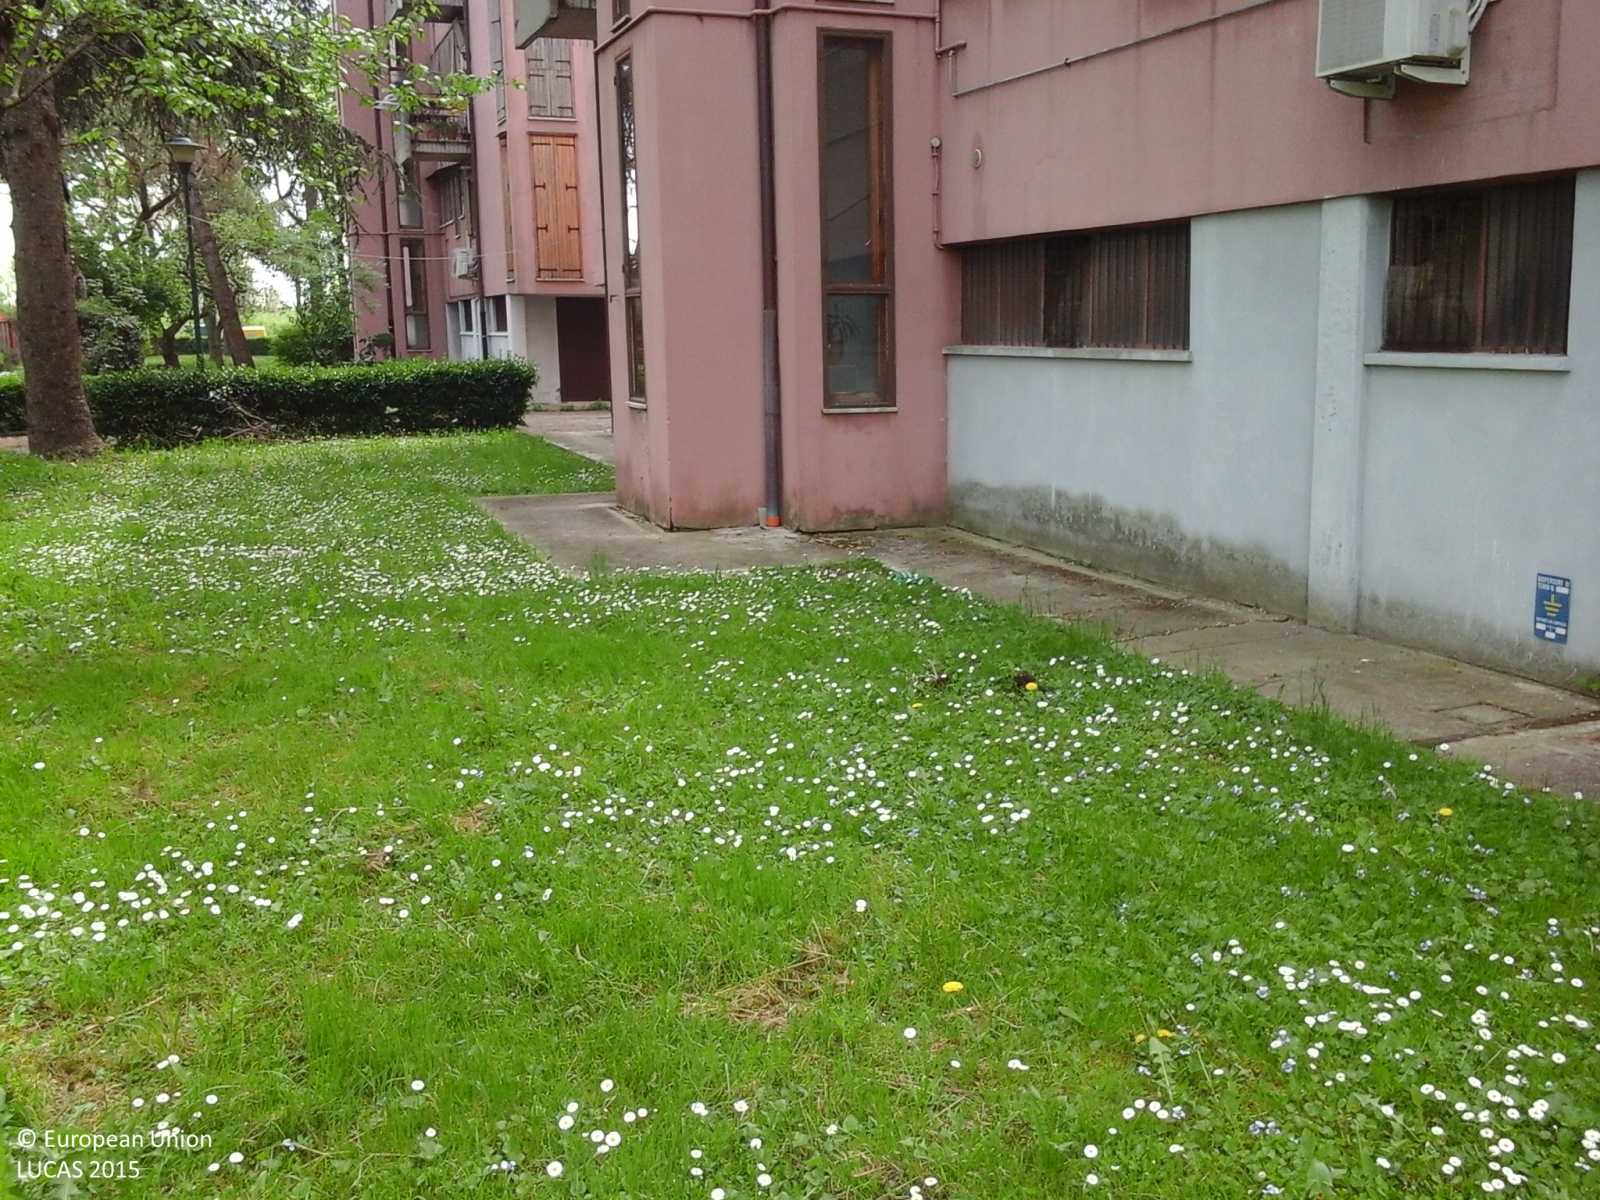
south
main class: Woodland
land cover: Broadleaved woodland
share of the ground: 50 - 75 %
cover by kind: broadleaved forest trees 70 %, herbaceous plants 30 %
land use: Residential
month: April
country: IT
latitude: 45.4797
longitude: 12.2864
